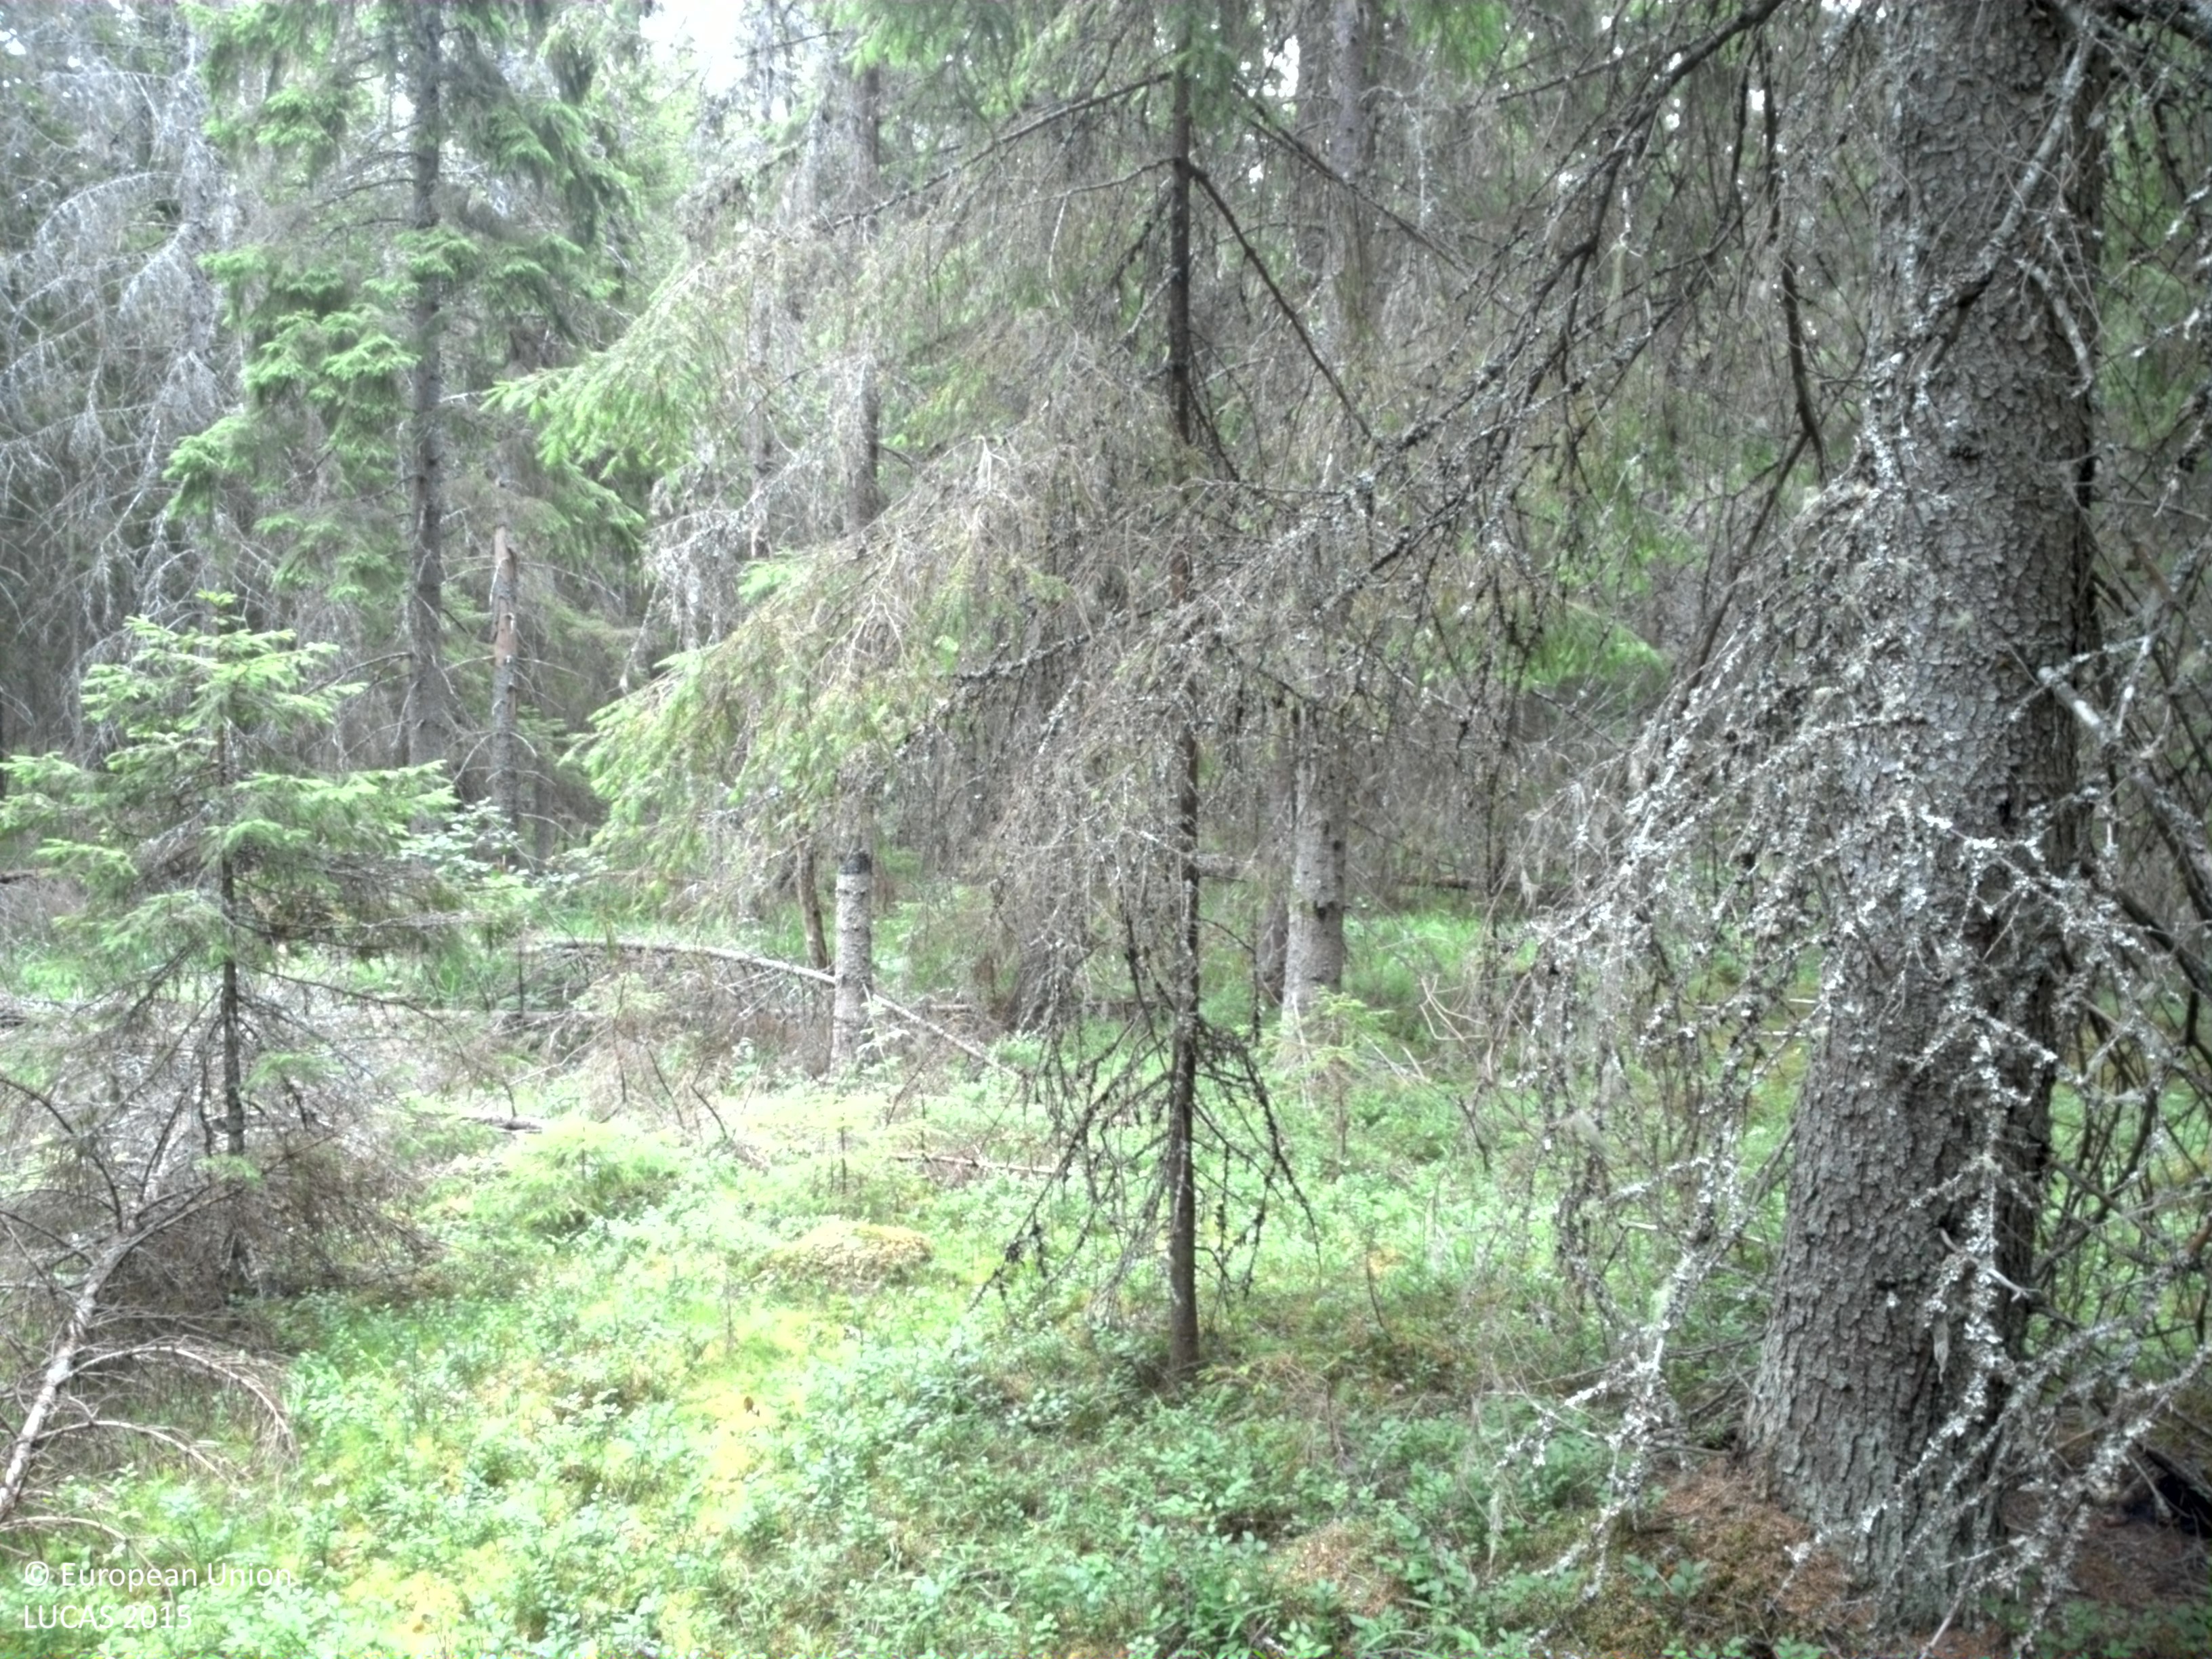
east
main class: Woodland
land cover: Spruce dominated coniferous woodland
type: boreal forest
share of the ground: 50 - 75 %
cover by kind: coniferous forest trees 75 %, lichens and mosses 15 %, herbaceous plants 10 %
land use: Forestry
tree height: > 5 m
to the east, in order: Spruce dominated coniferous woodland; Spruce dominated mixed woodland; Spruce dominated coniferous woodland; Spruce dominated mixed woodland; Lichens and moss; Spruce dominated mixed woodland; Spruce dominated coniferous woodland; Spruce dominated mixed woodland; Spruce dominated coniferous woodland
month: July
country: SE
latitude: 60.0556
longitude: 18.4203
